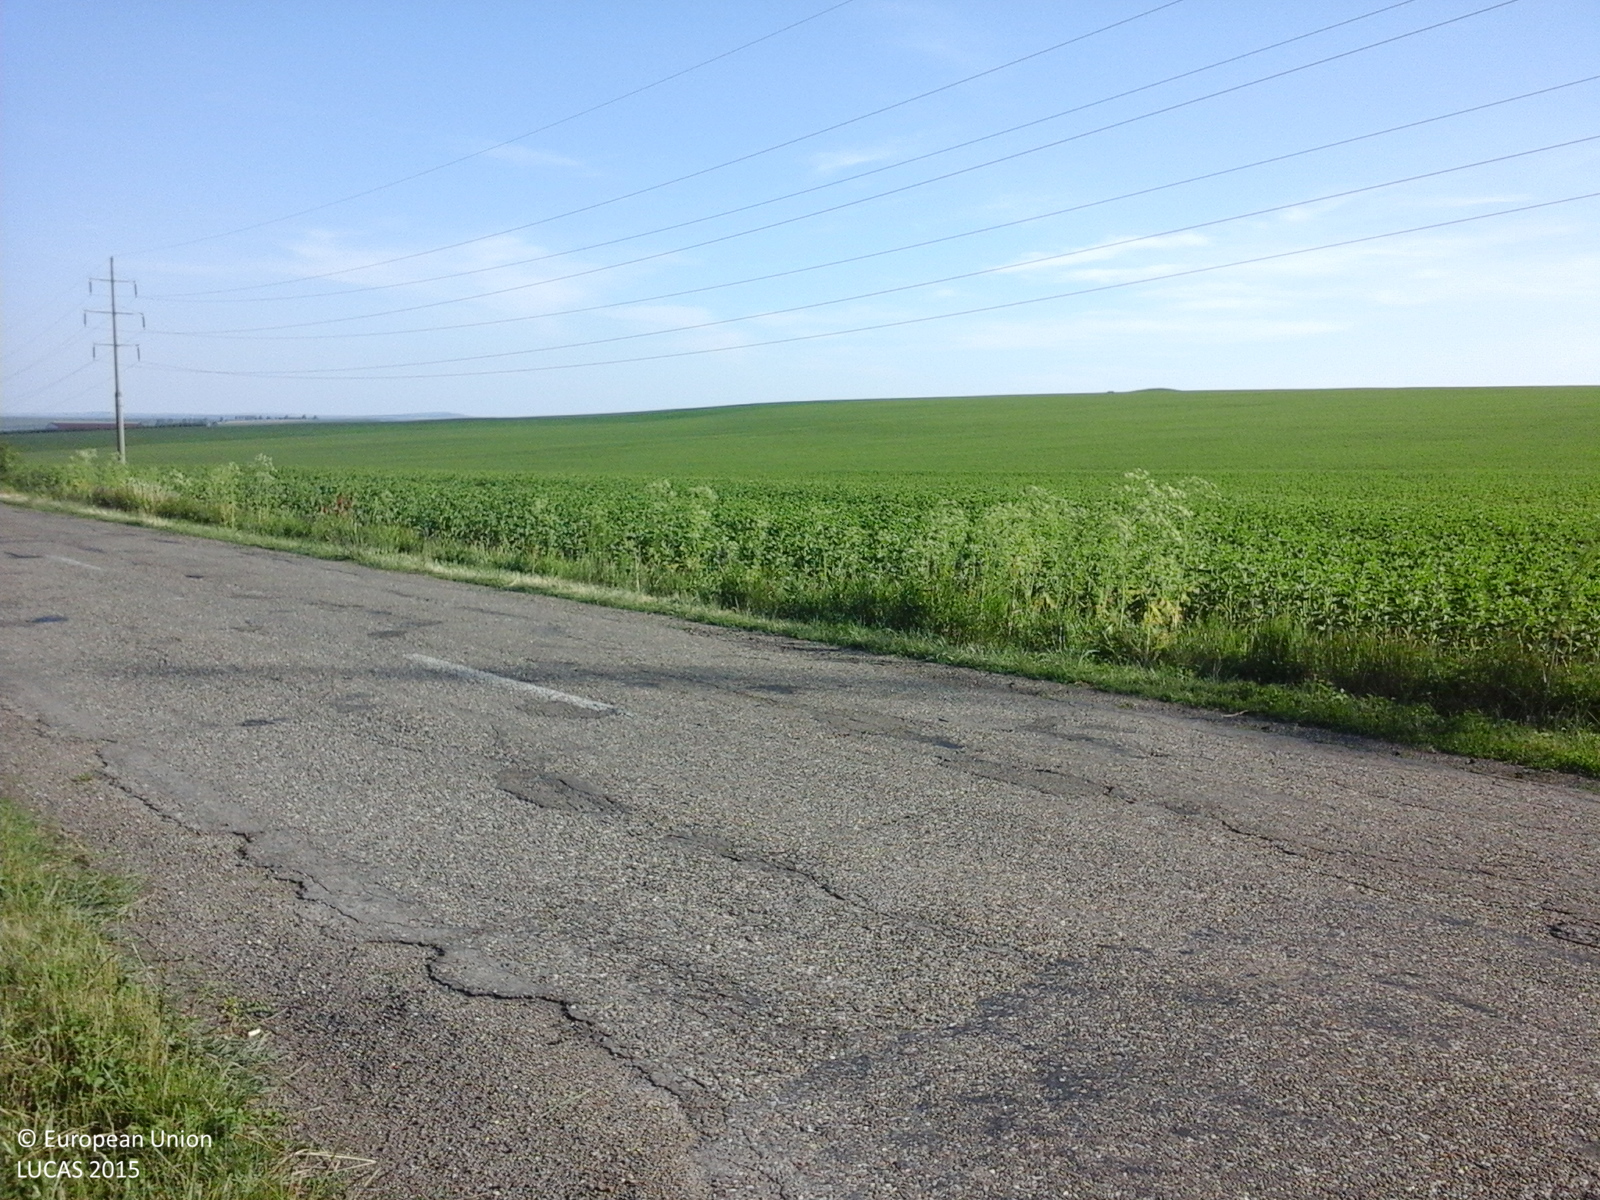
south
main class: Cropland
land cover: Common wheat
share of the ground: > 75 %
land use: Agriculture (excluding fallow land and kitchen gardens)
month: June
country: RO
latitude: 47.8939
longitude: 27.1641
